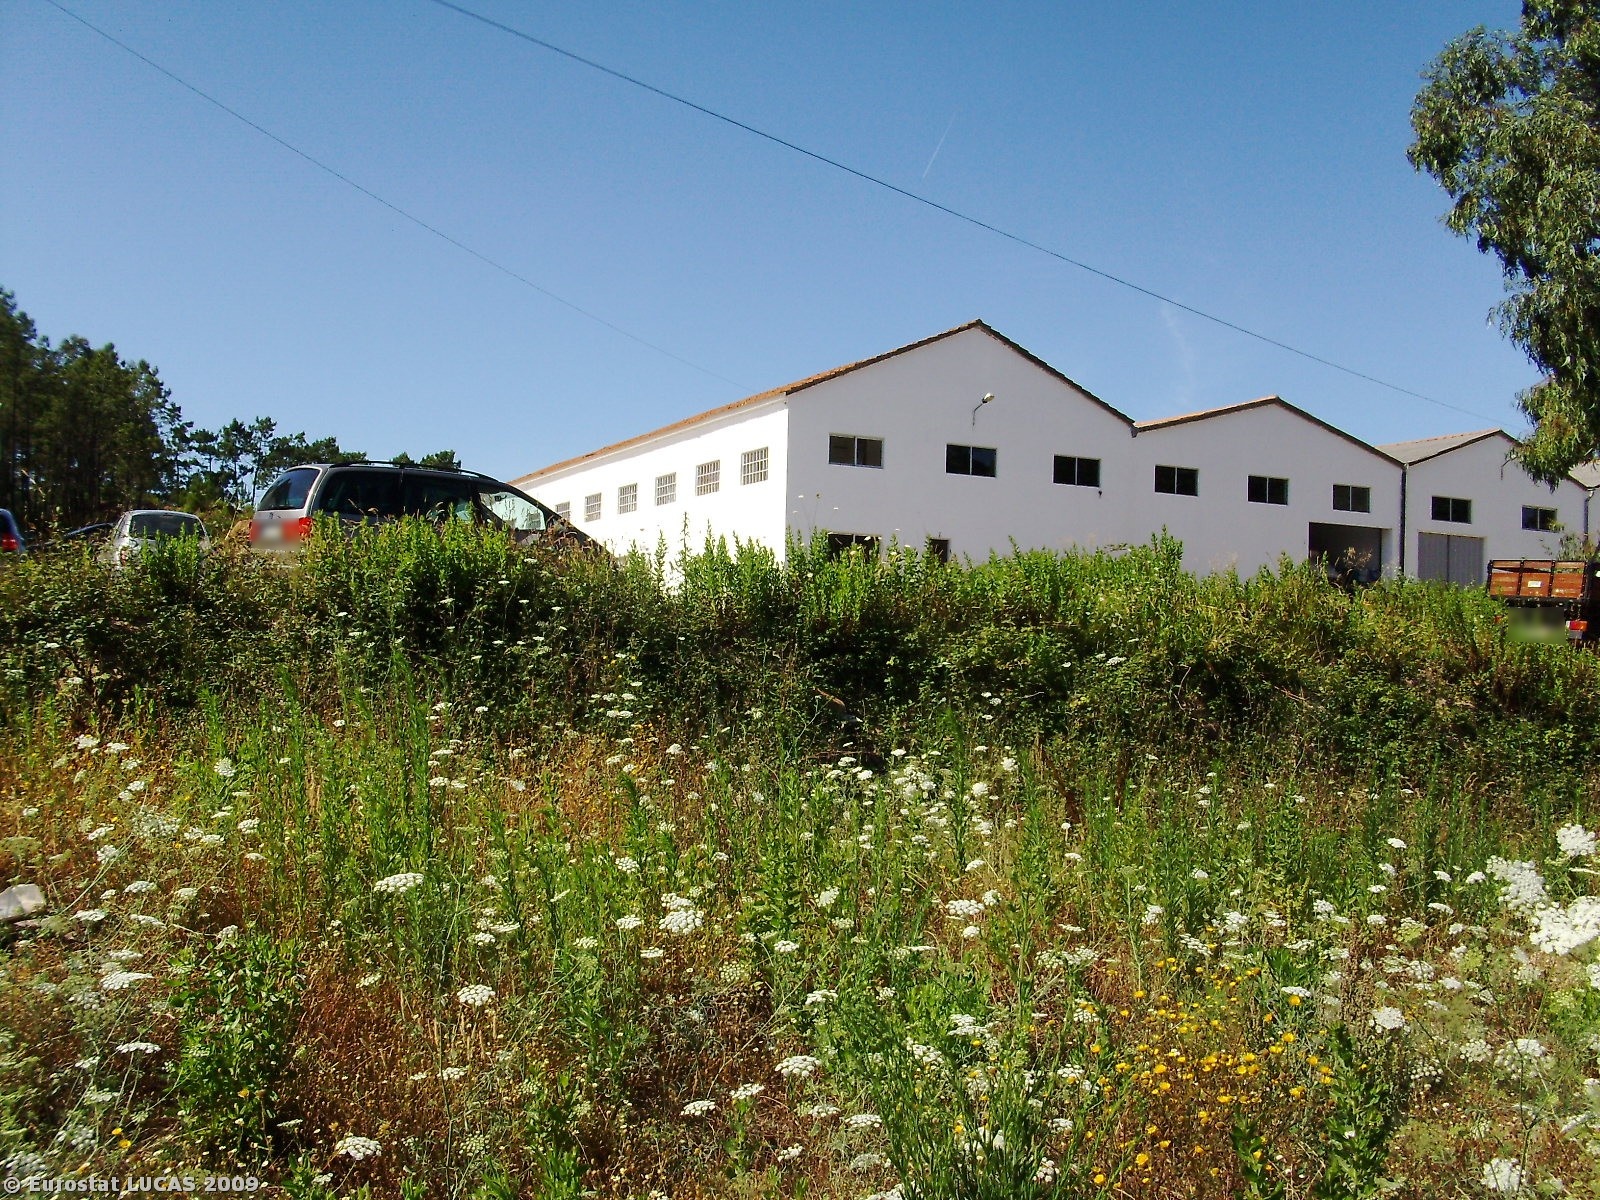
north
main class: Grassland
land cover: Spontaneously vegetated surfaces
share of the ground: > 75 %
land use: Fallow land
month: July
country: PT
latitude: 39.6810
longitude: -8.9415
